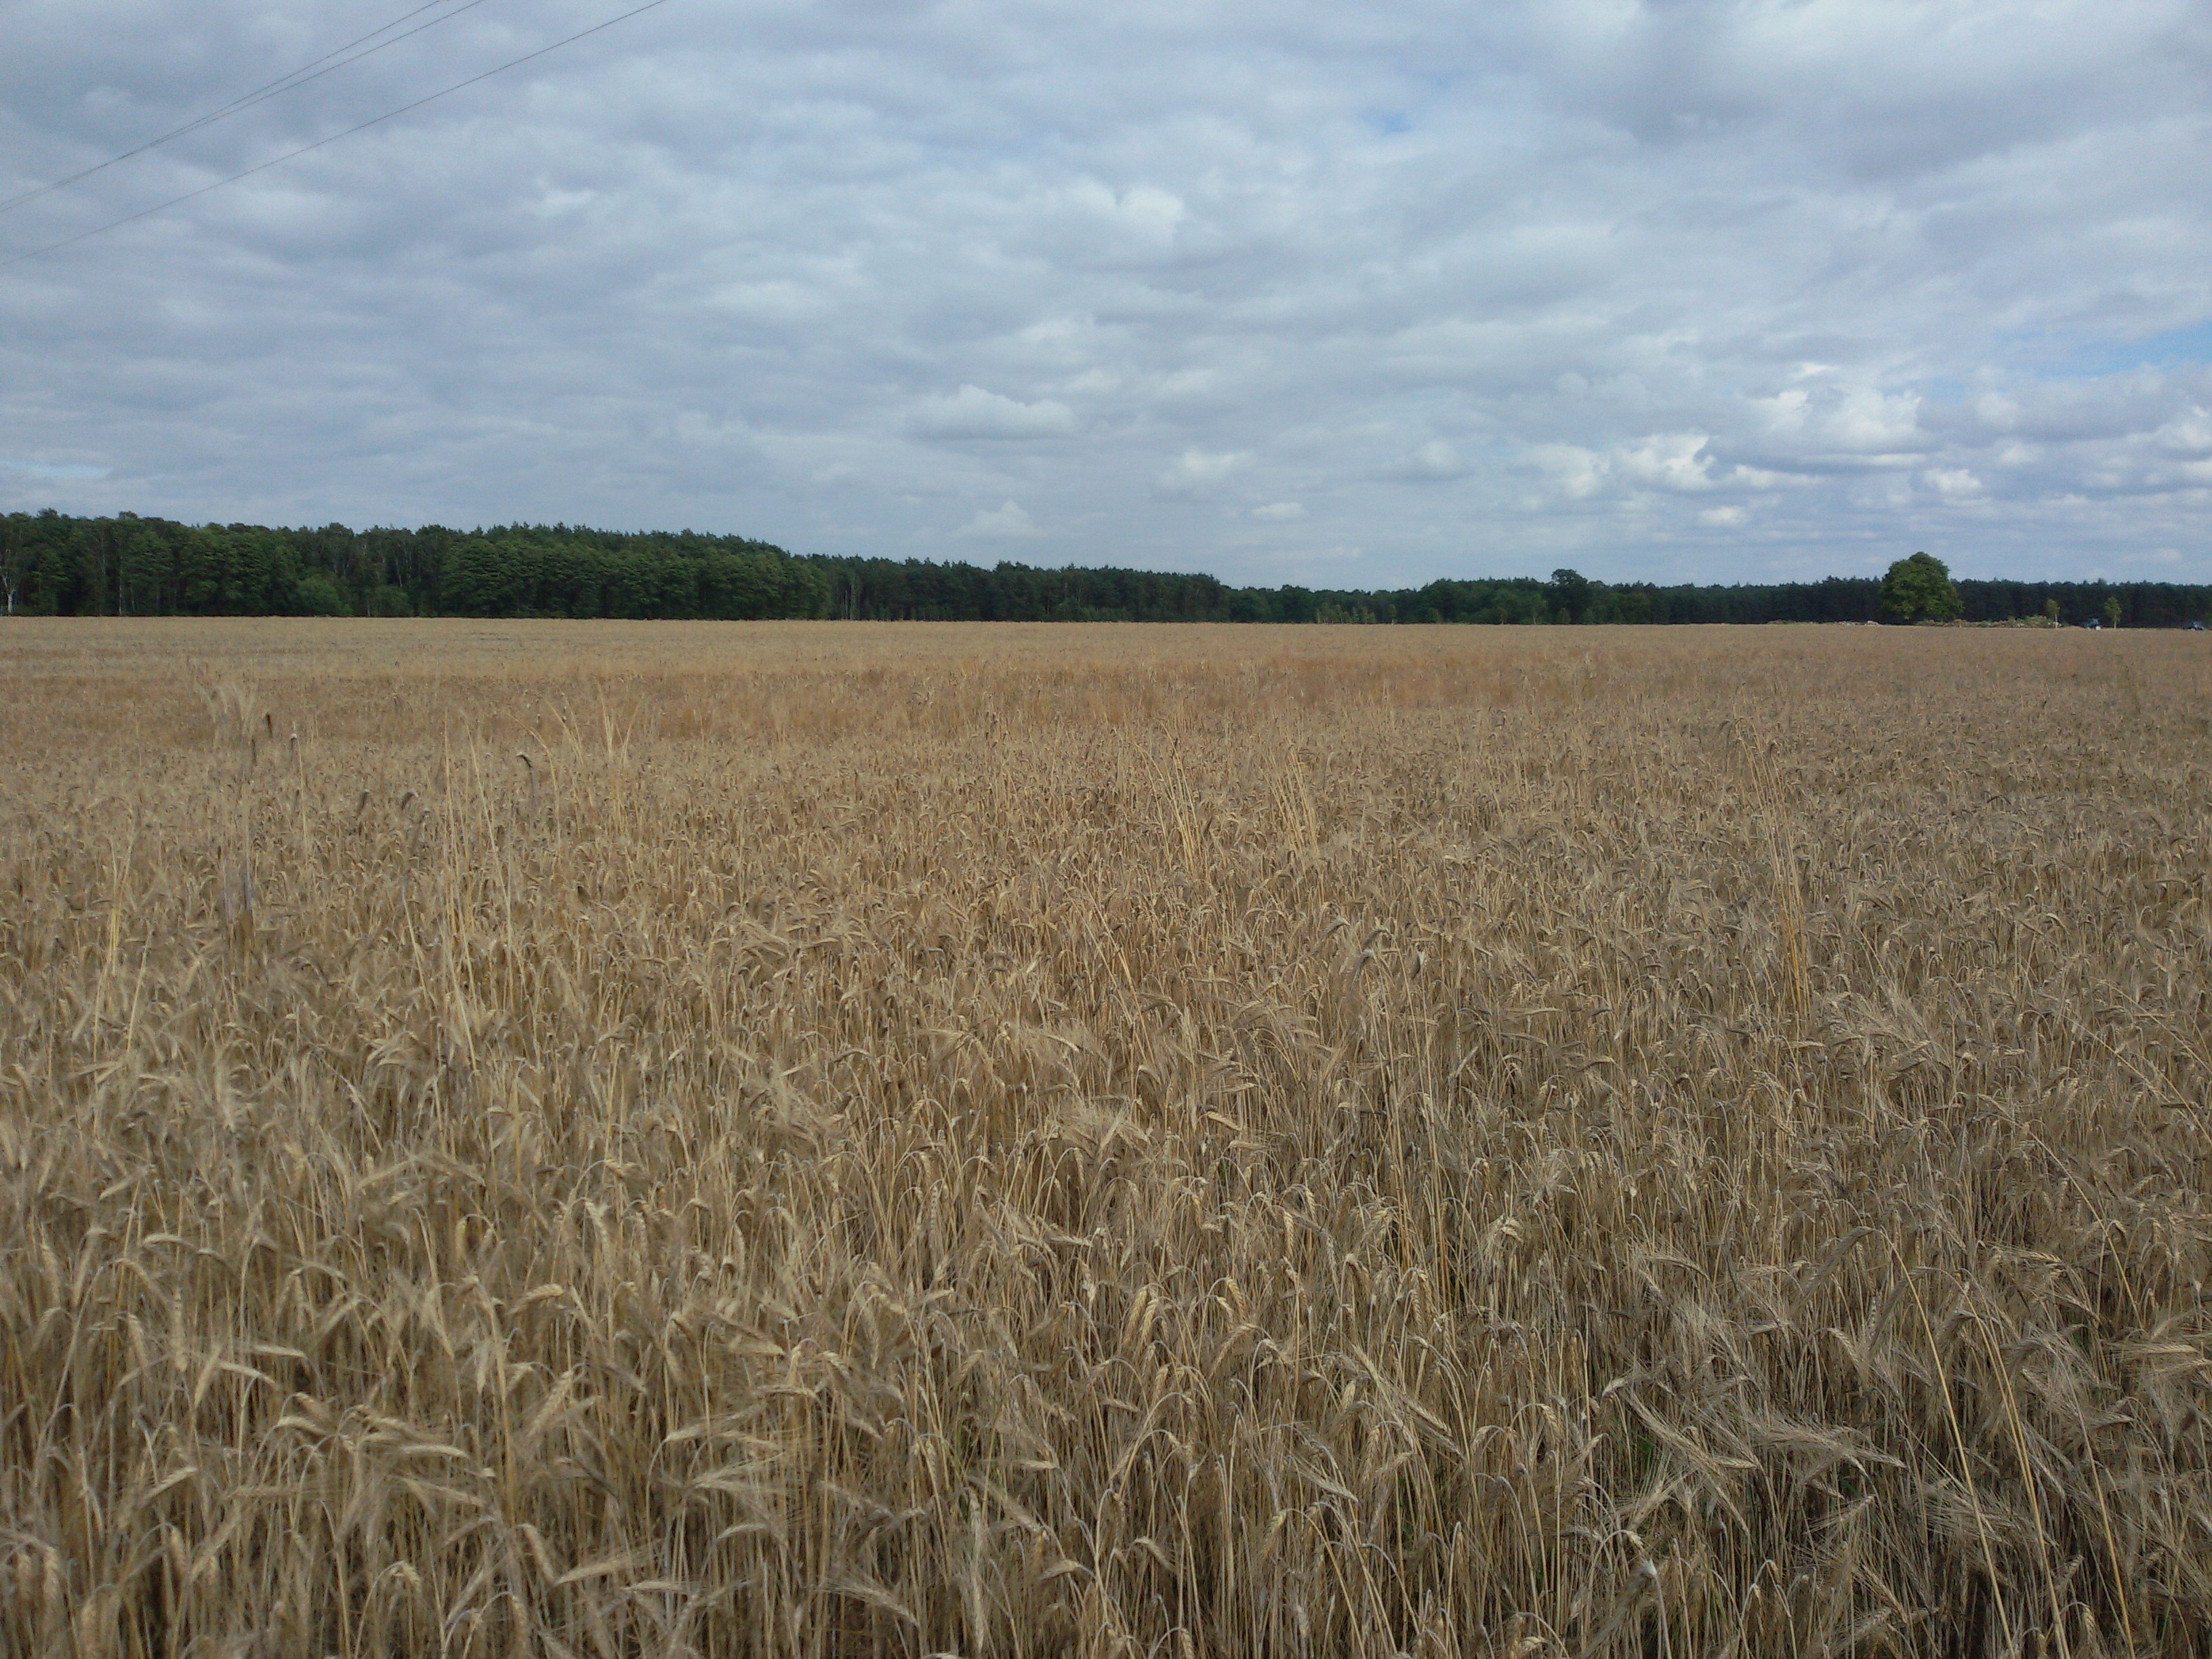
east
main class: Cropland
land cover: Triticale
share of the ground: > 75 %
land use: Agriculture (excluding fallow land and kitchen gardens)
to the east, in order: Triticale; Electric lines; Triticale; Grassland with sparse tree/shrub cover; Triticale
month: July
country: PL
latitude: 52.8384
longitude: 17.0017
